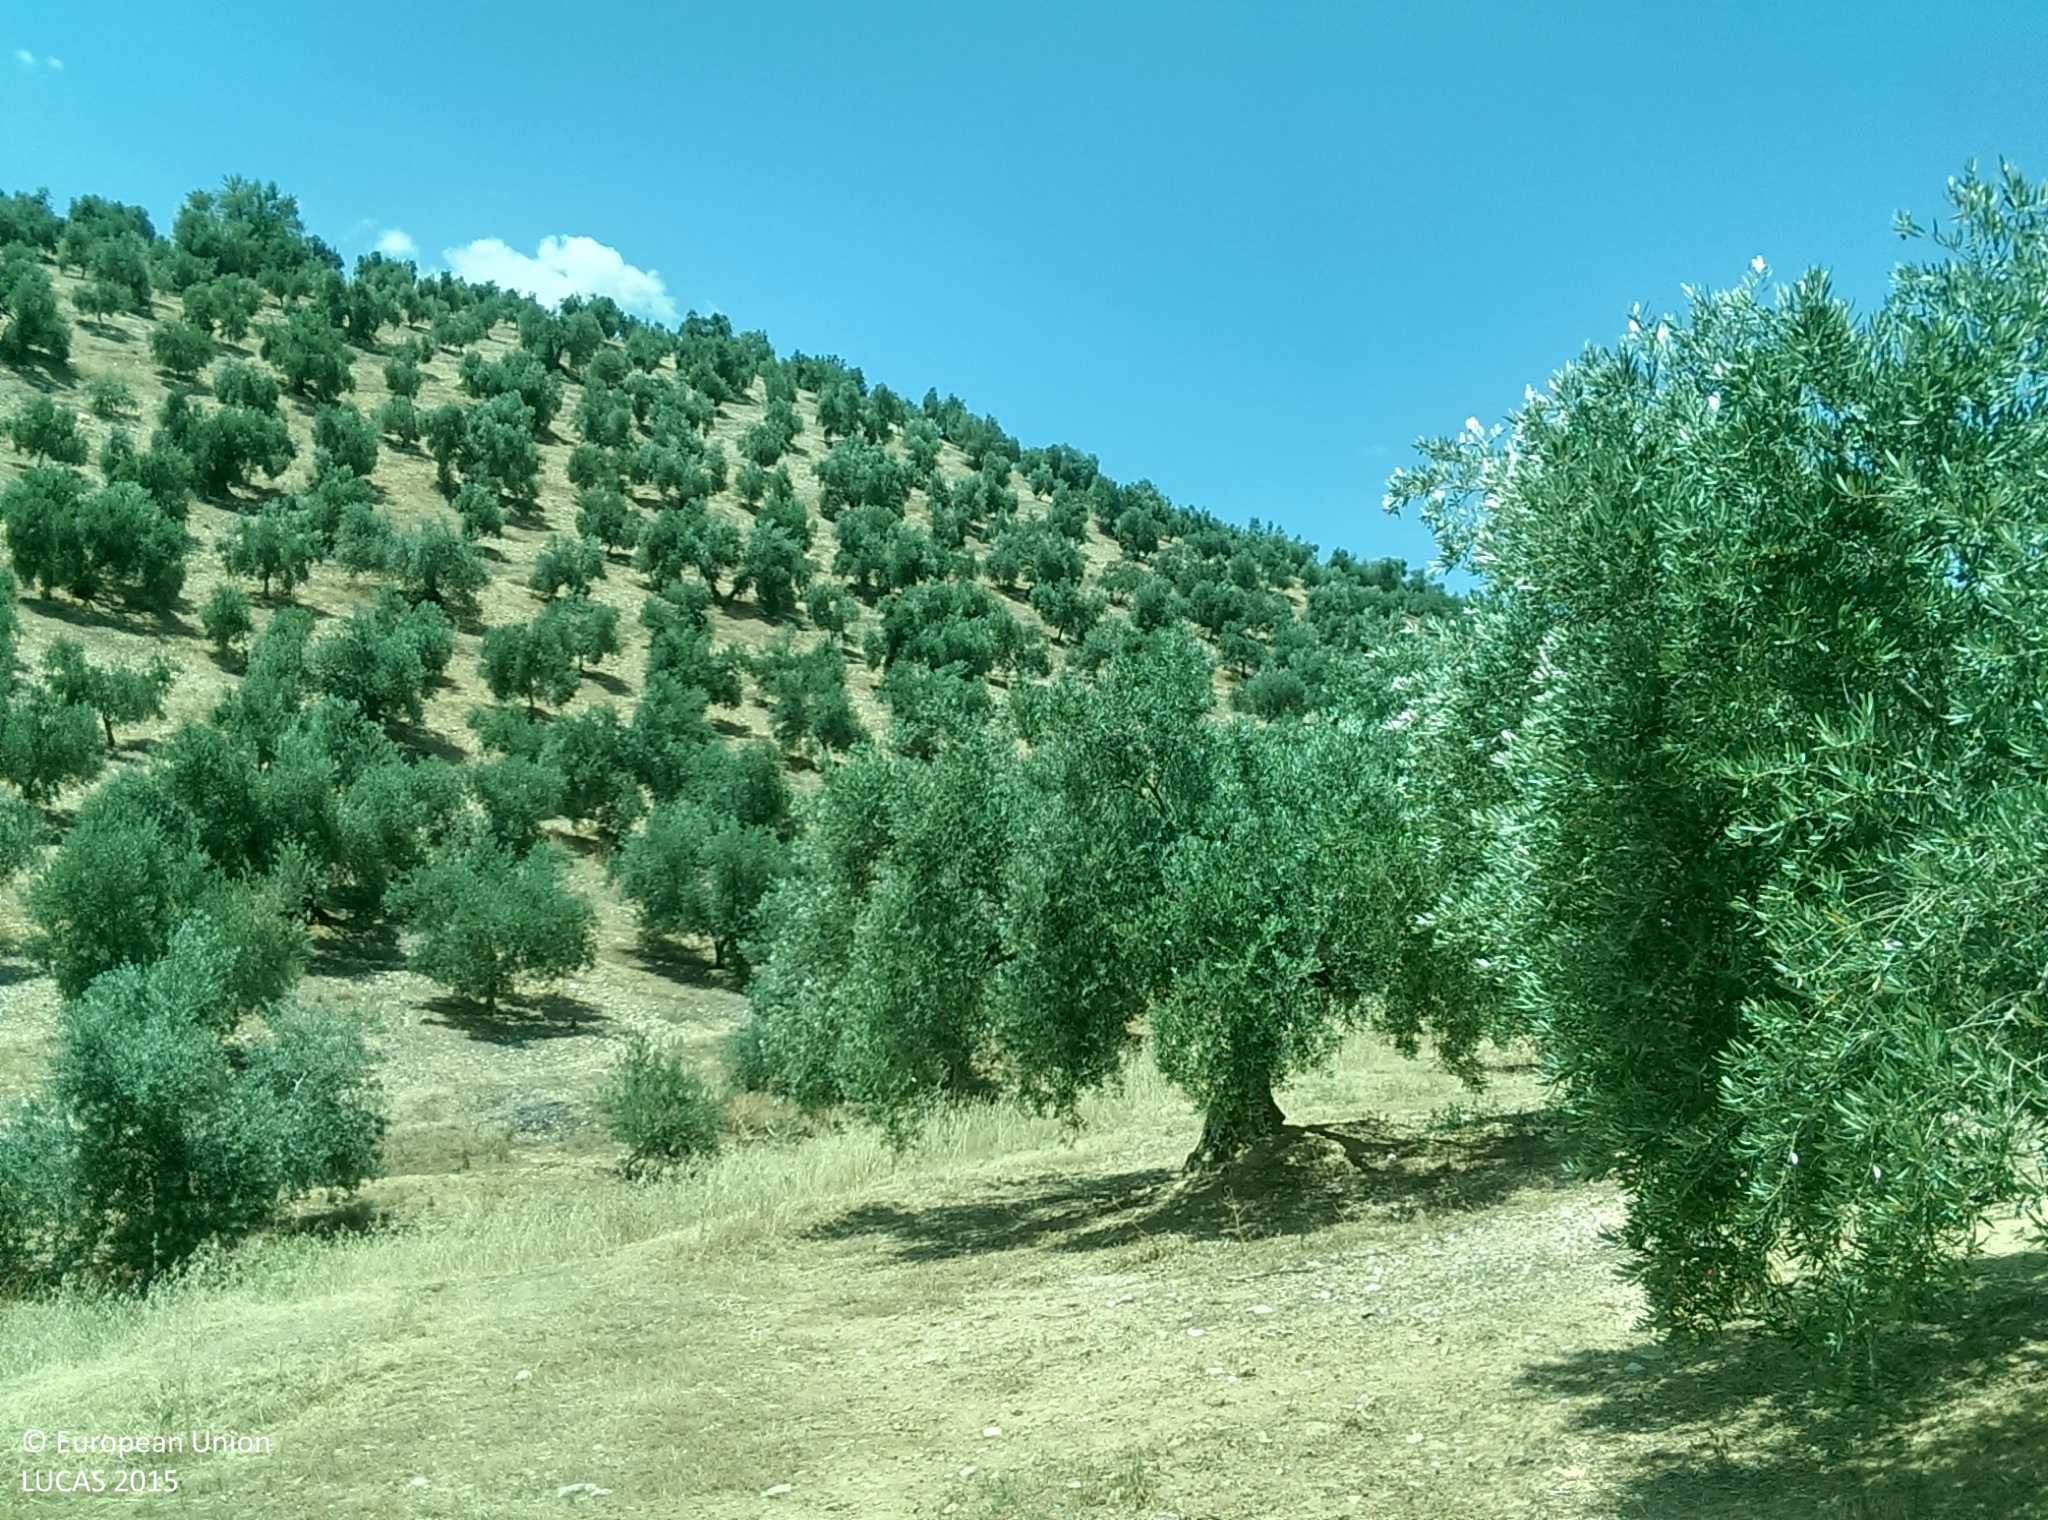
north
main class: Cropland
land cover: Olive groves
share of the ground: 50 - 75 %
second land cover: Spontaneously vegetated surfaces
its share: 10 - 25 %
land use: Agriculture (excluding fallow land and kitchen gardens)
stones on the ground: 10 - 25 %
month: July
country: ES
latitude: 37.4479
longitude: -3.7060
